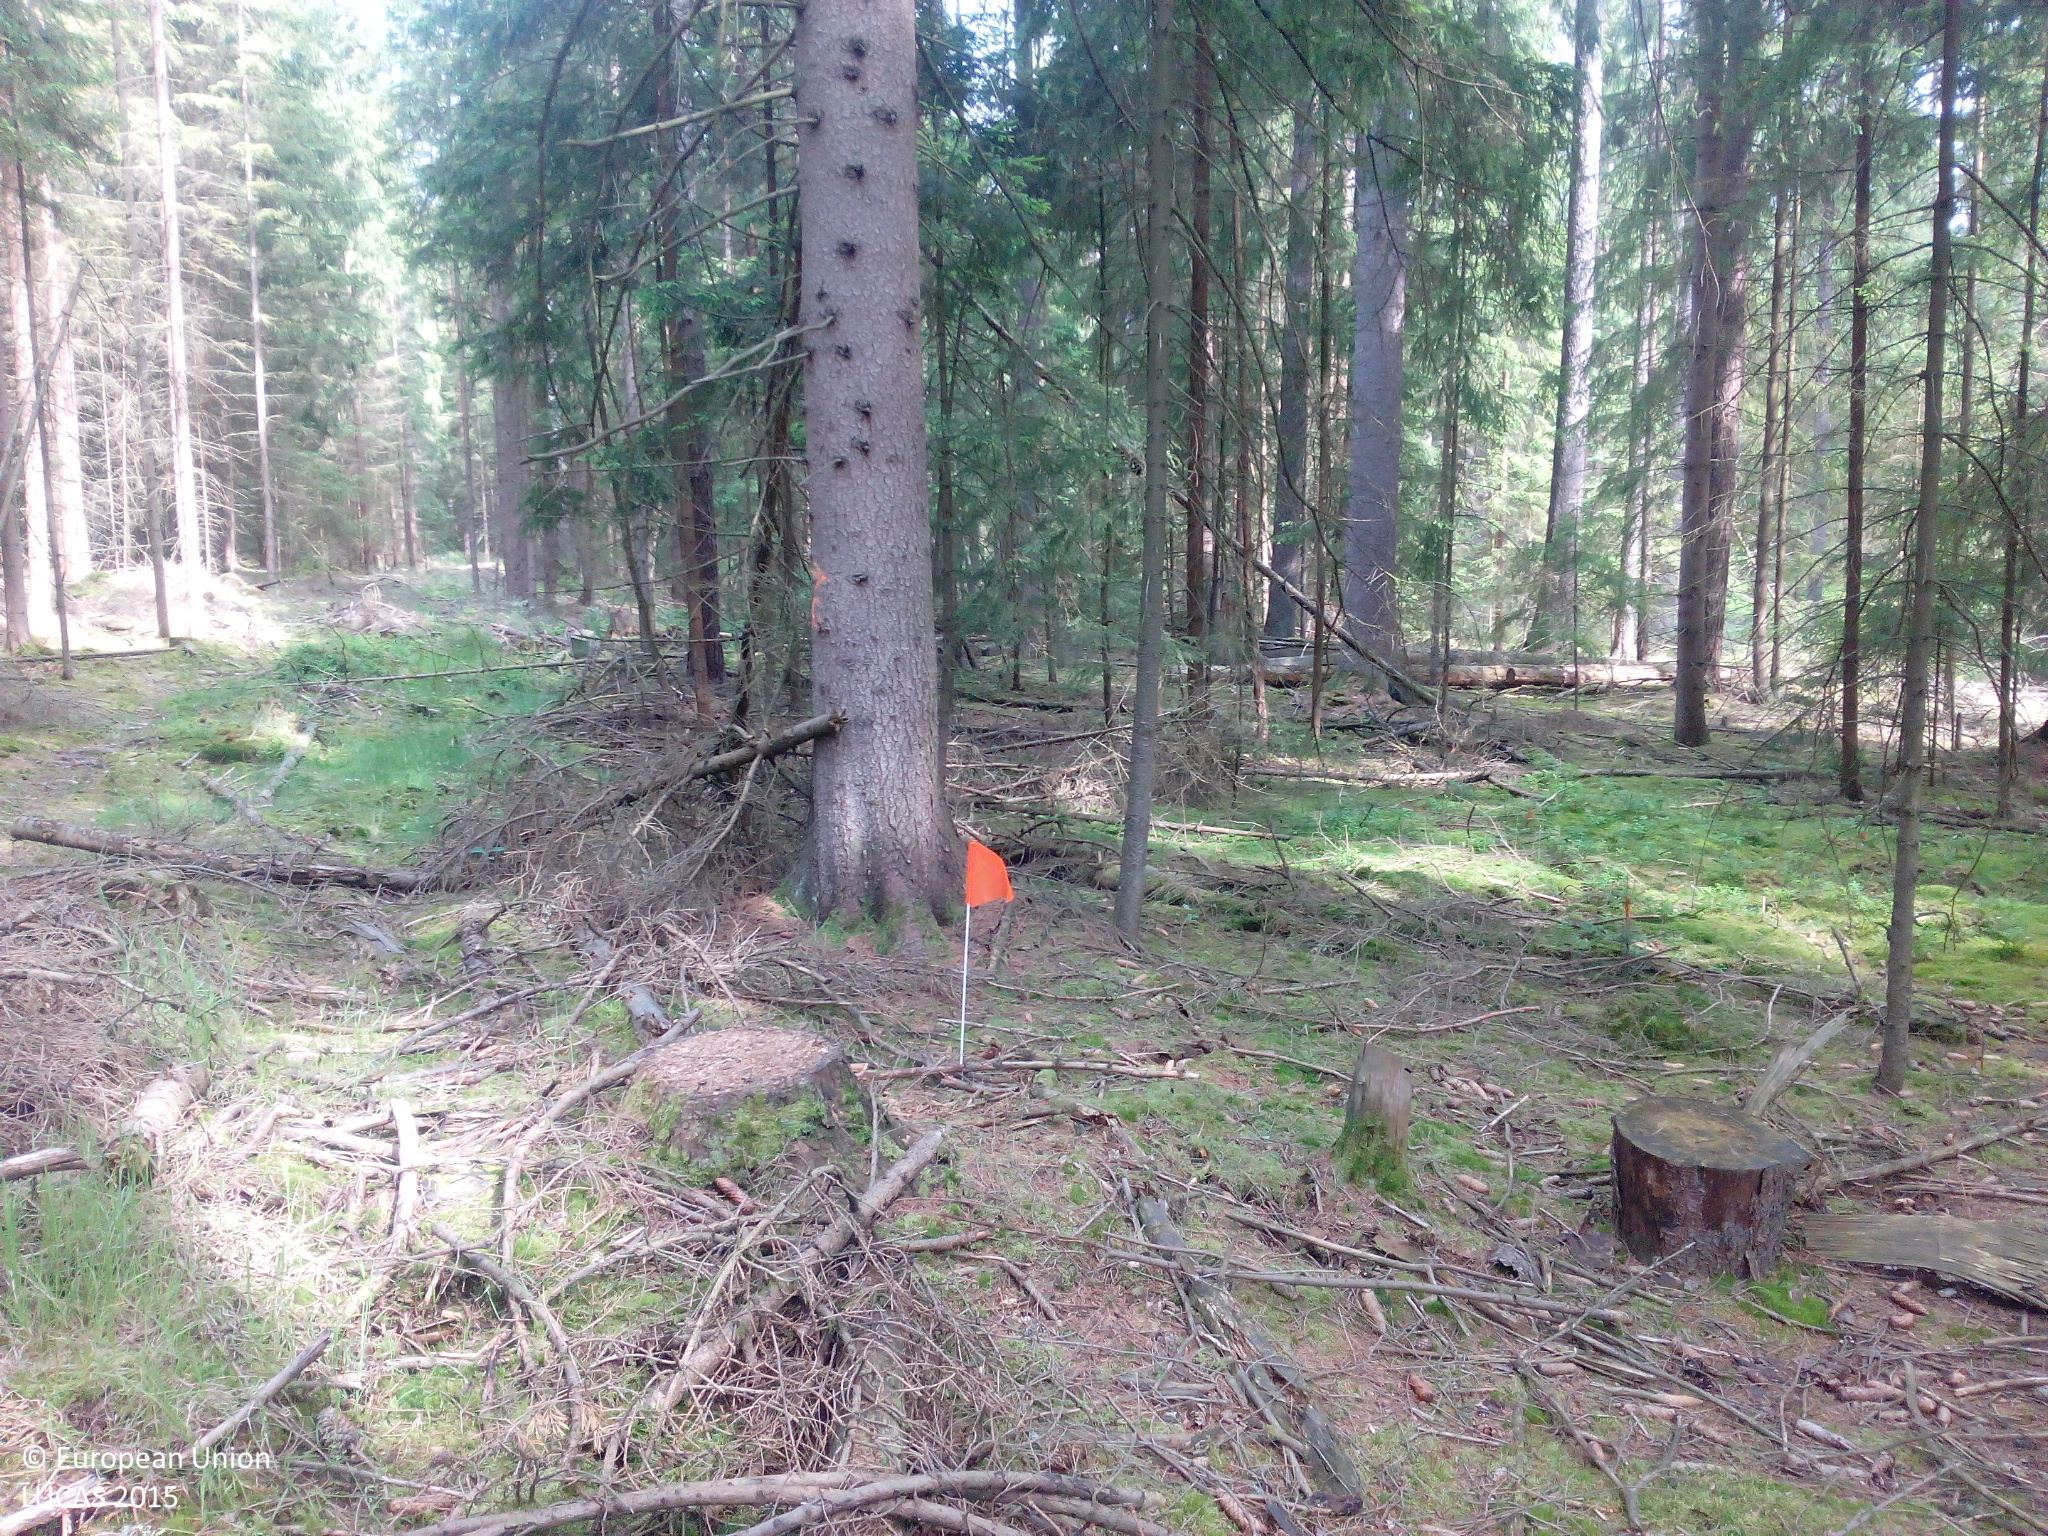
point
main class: Woodland
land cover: Spruce dominated coniferous woodland
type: hemiboreal forest and nemoral coniferous forest and mixed broadleaved-coniferous forest
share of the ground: 50 - 75 %
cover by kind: coniferous forest trees 65 %, herbaceous plants 20 %, shrubs 10 %
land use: Forestry
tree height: > 5 m
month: June
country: DE
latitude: 50.0721
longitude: 12.2491
